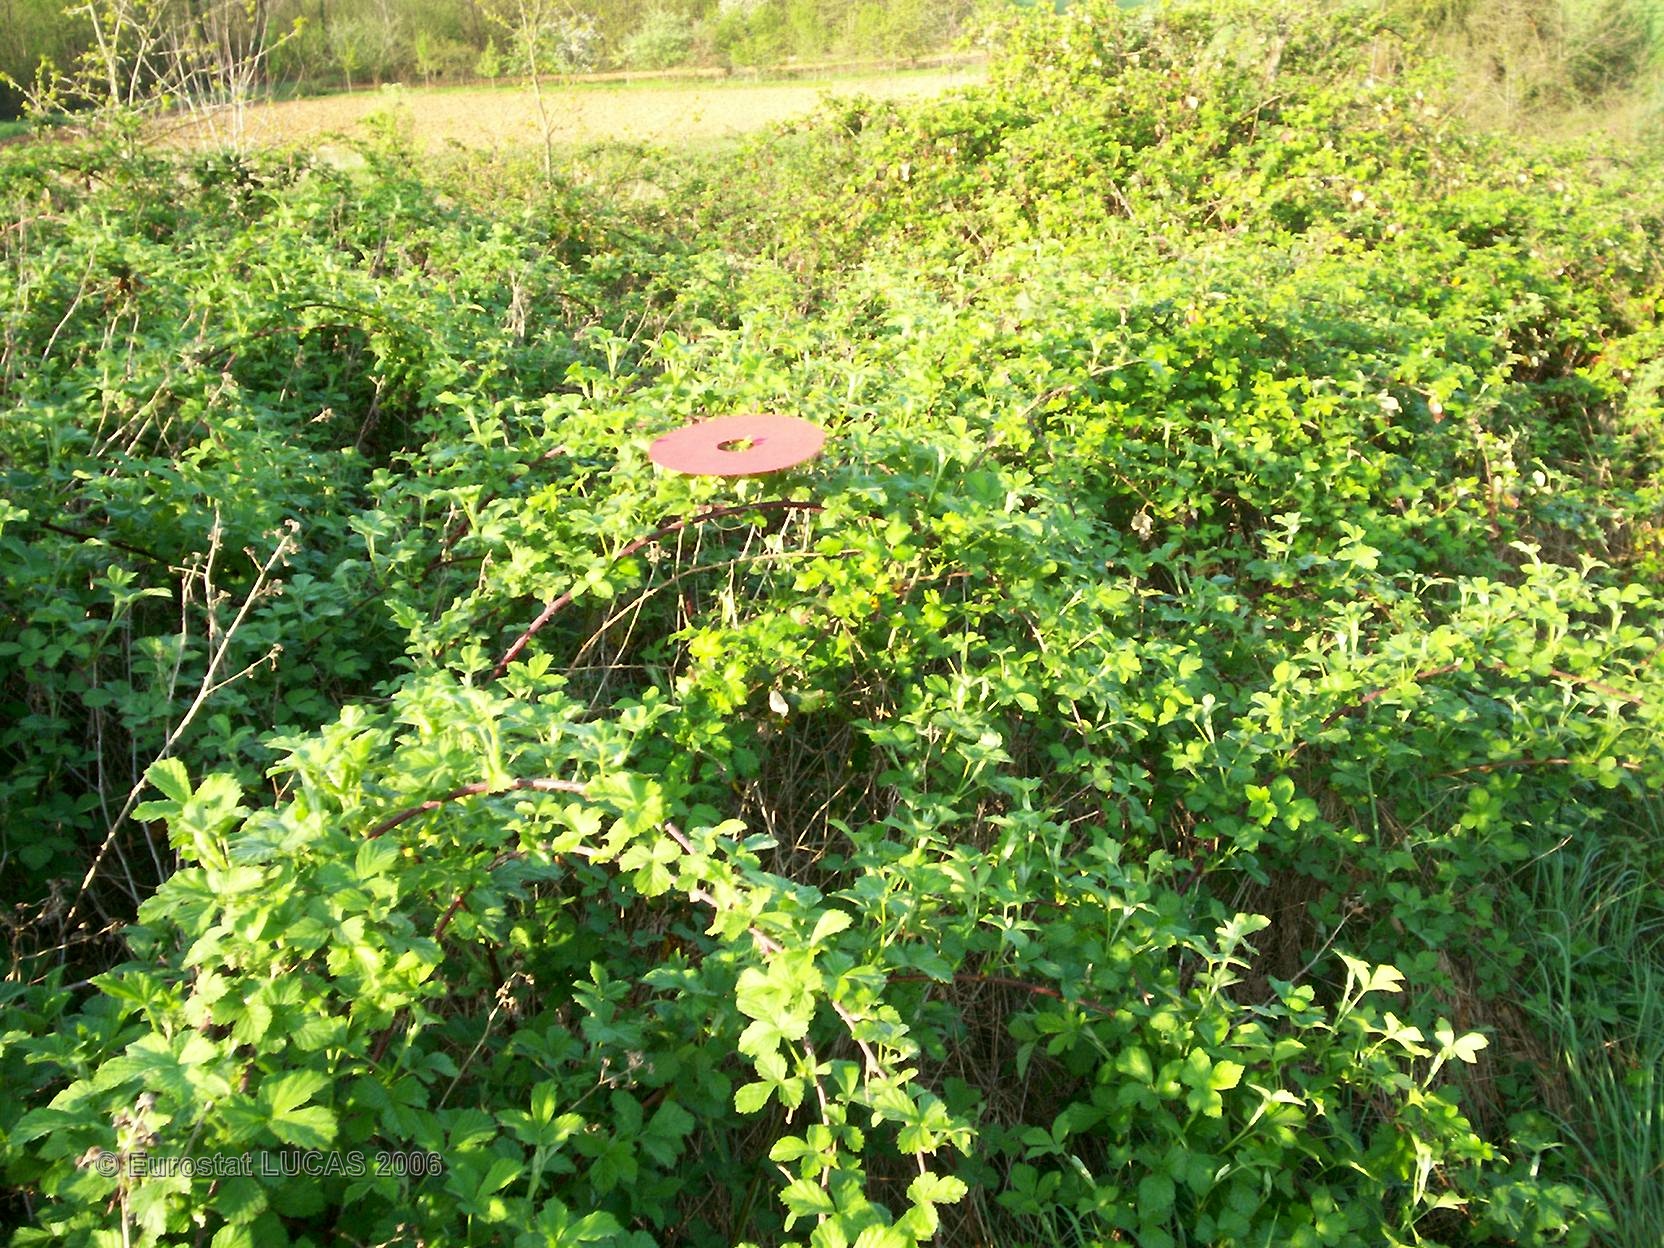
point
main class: Grassland
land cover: Grassland with sparse tree/shrub cover
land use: Unused
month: April
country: FR
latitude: 45.5198
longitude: 0.6037
